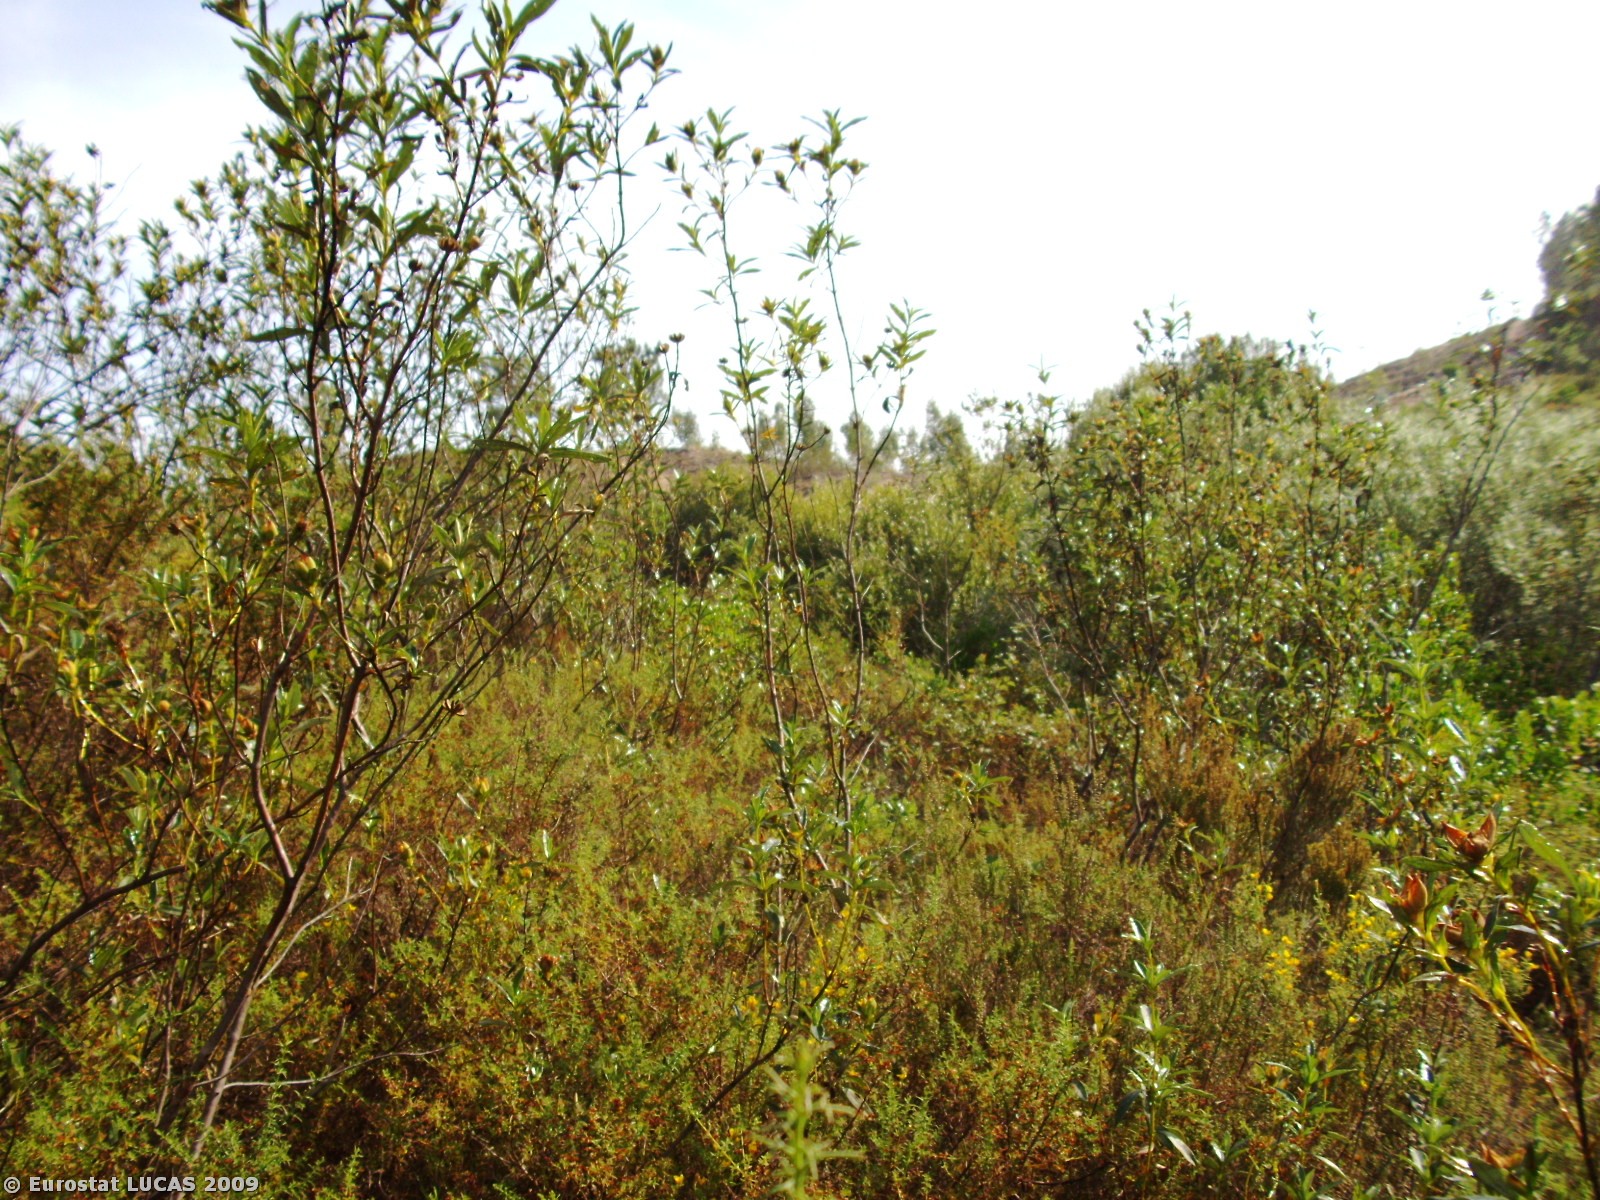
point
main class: Shrubland
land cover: Shrubland without tree cover
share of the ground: > 75 %
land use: Unused
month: June
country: PT
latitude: 37.3850
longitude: -8.7508
